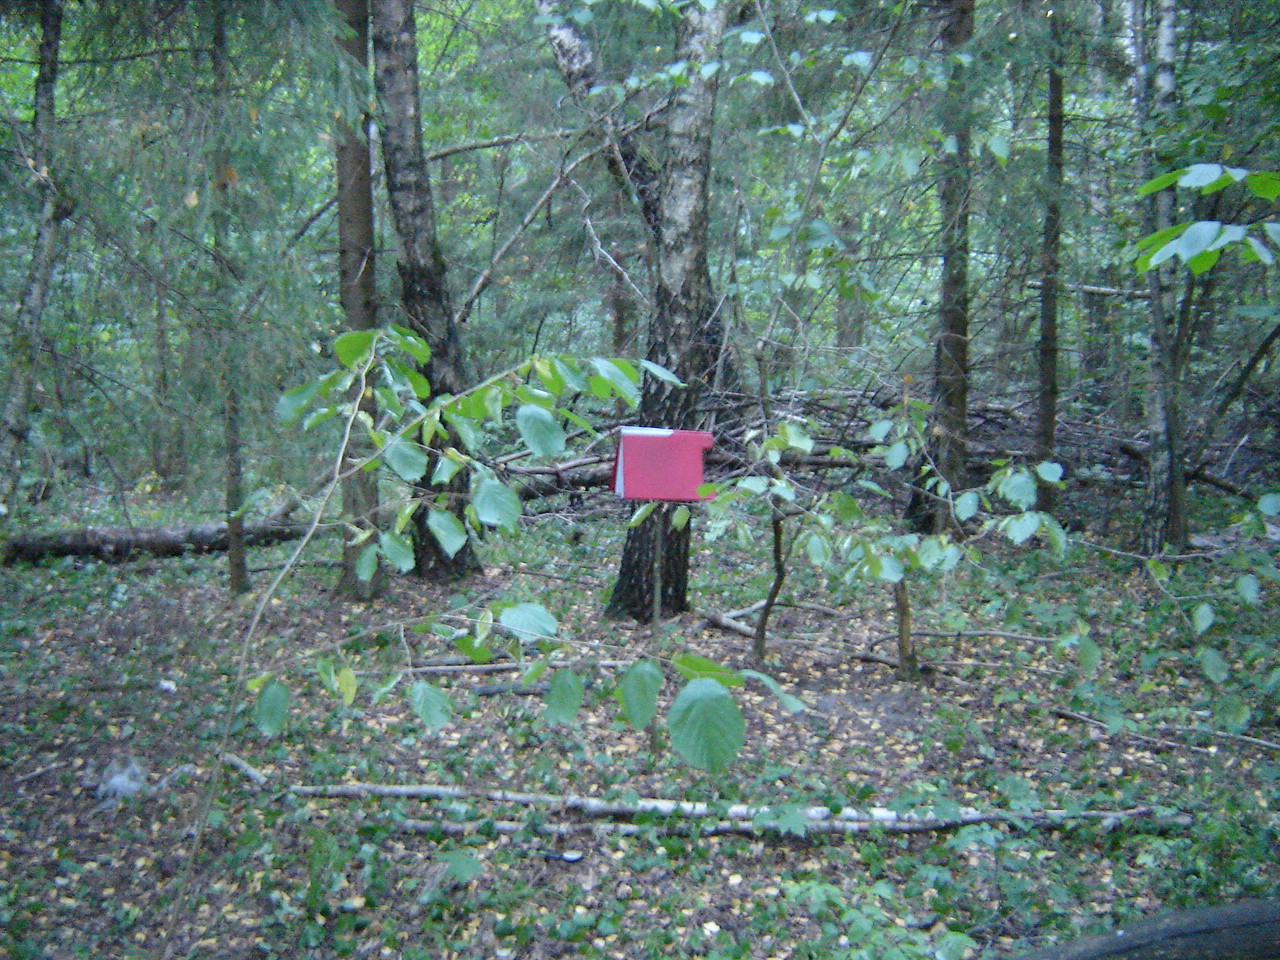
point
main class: Woodland
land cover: Spruce dominated mixed woodland
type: hemiboreal forest and nemoral coniferous forest and mixed broadleaved-coniferous forest
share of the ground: > 75 %
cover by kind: coniferous forest trees 55 %, broadleaved forest trees 35 %, herbaceous plants 10 %
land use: Forestry
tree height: > 5 m
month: August
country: LT
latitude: 54.7023
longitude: 24.9325
